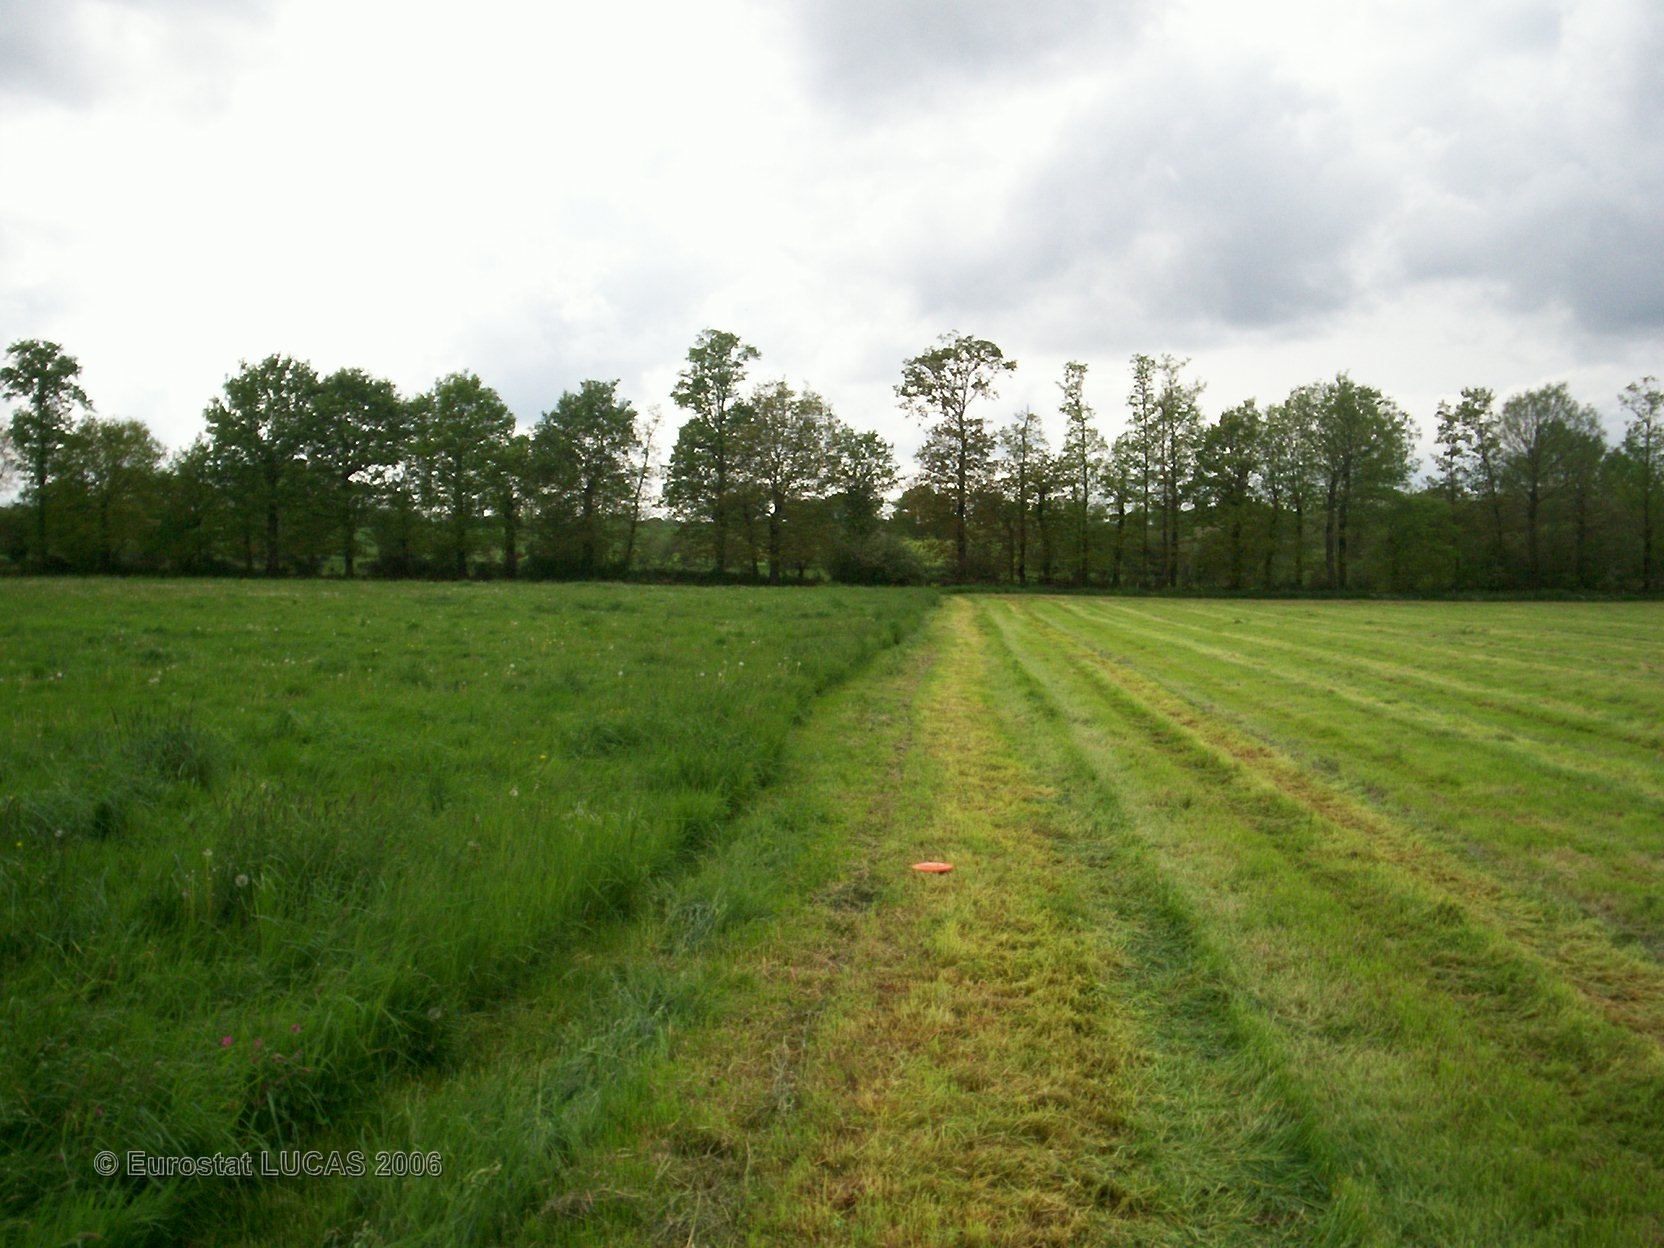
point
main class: Grassland
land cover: Grassland without tree/shrub cover
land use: Agriculture (excluding fallow land and kitchen gardens)
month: May
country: FR
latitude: 47.9434
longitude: -2.3607
